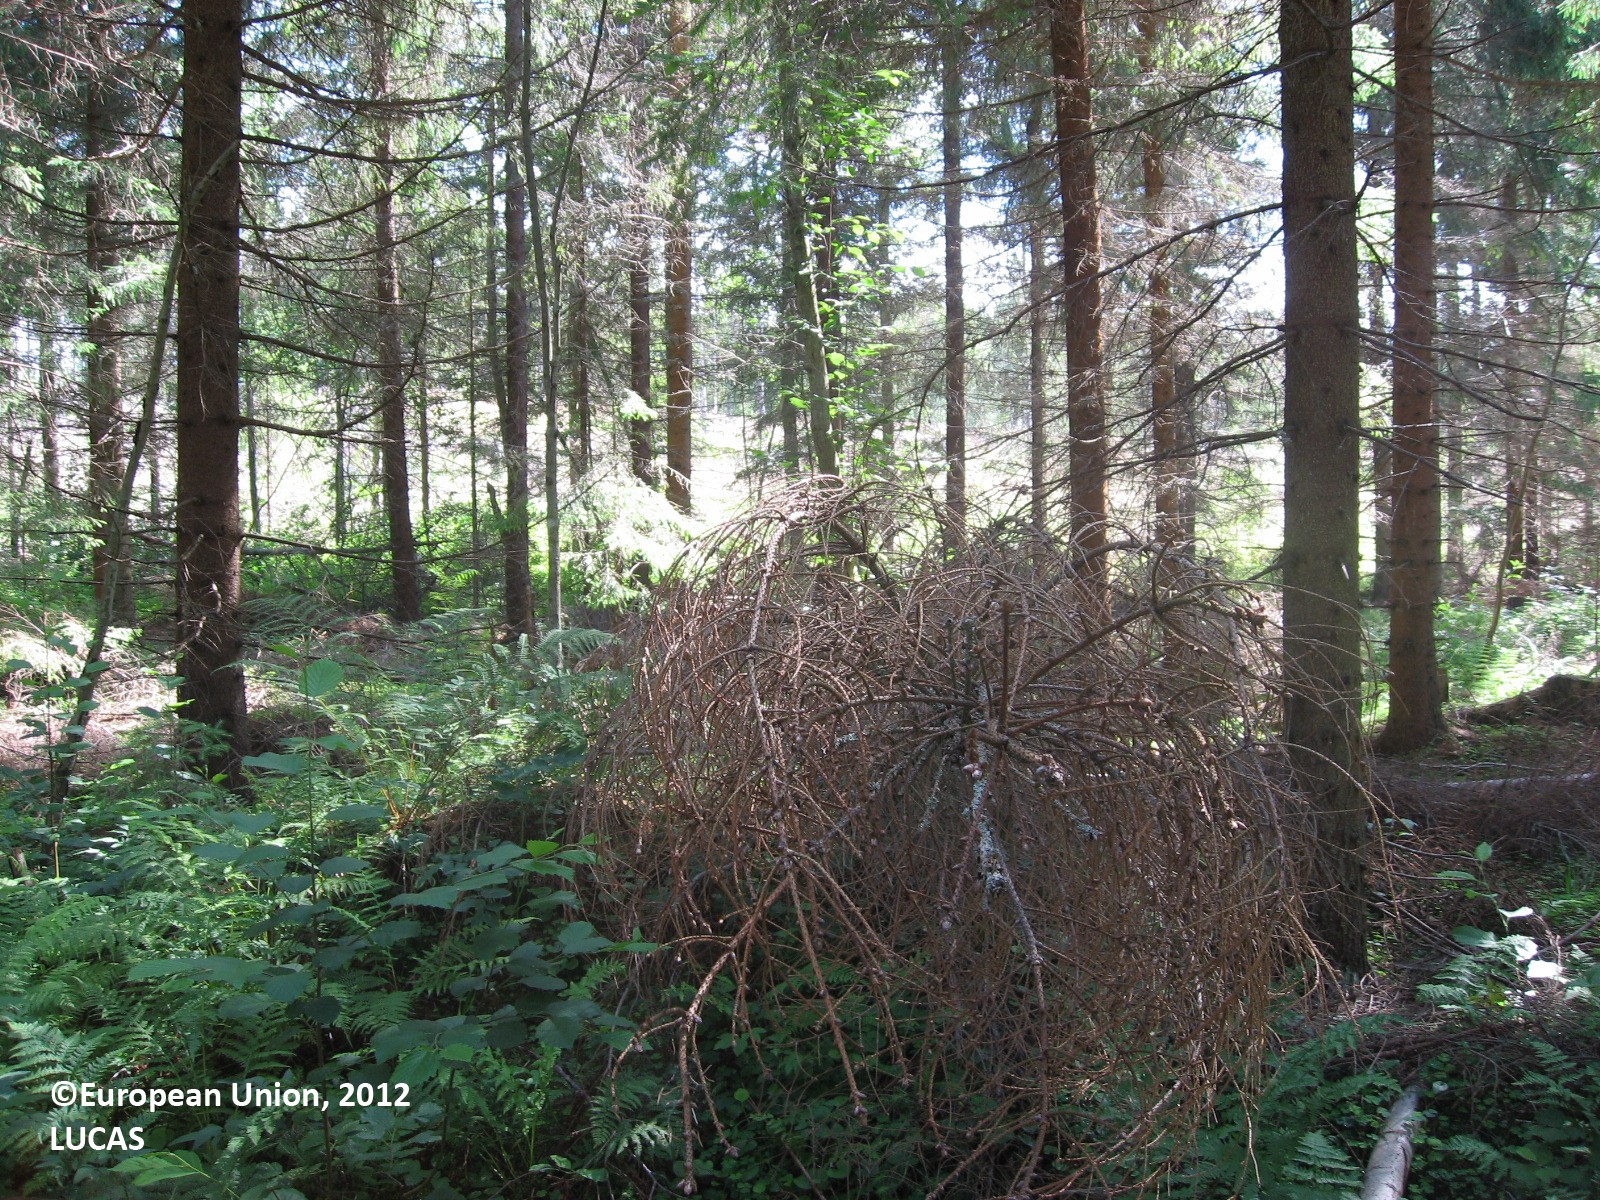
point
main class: Woodland
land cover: Spruce dominated coniferous woodland
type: boreal forest
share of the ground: > 75 %
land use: Forestry
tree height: > 5 m
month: July
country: FI
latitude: 61.1517
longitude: 25.7177
